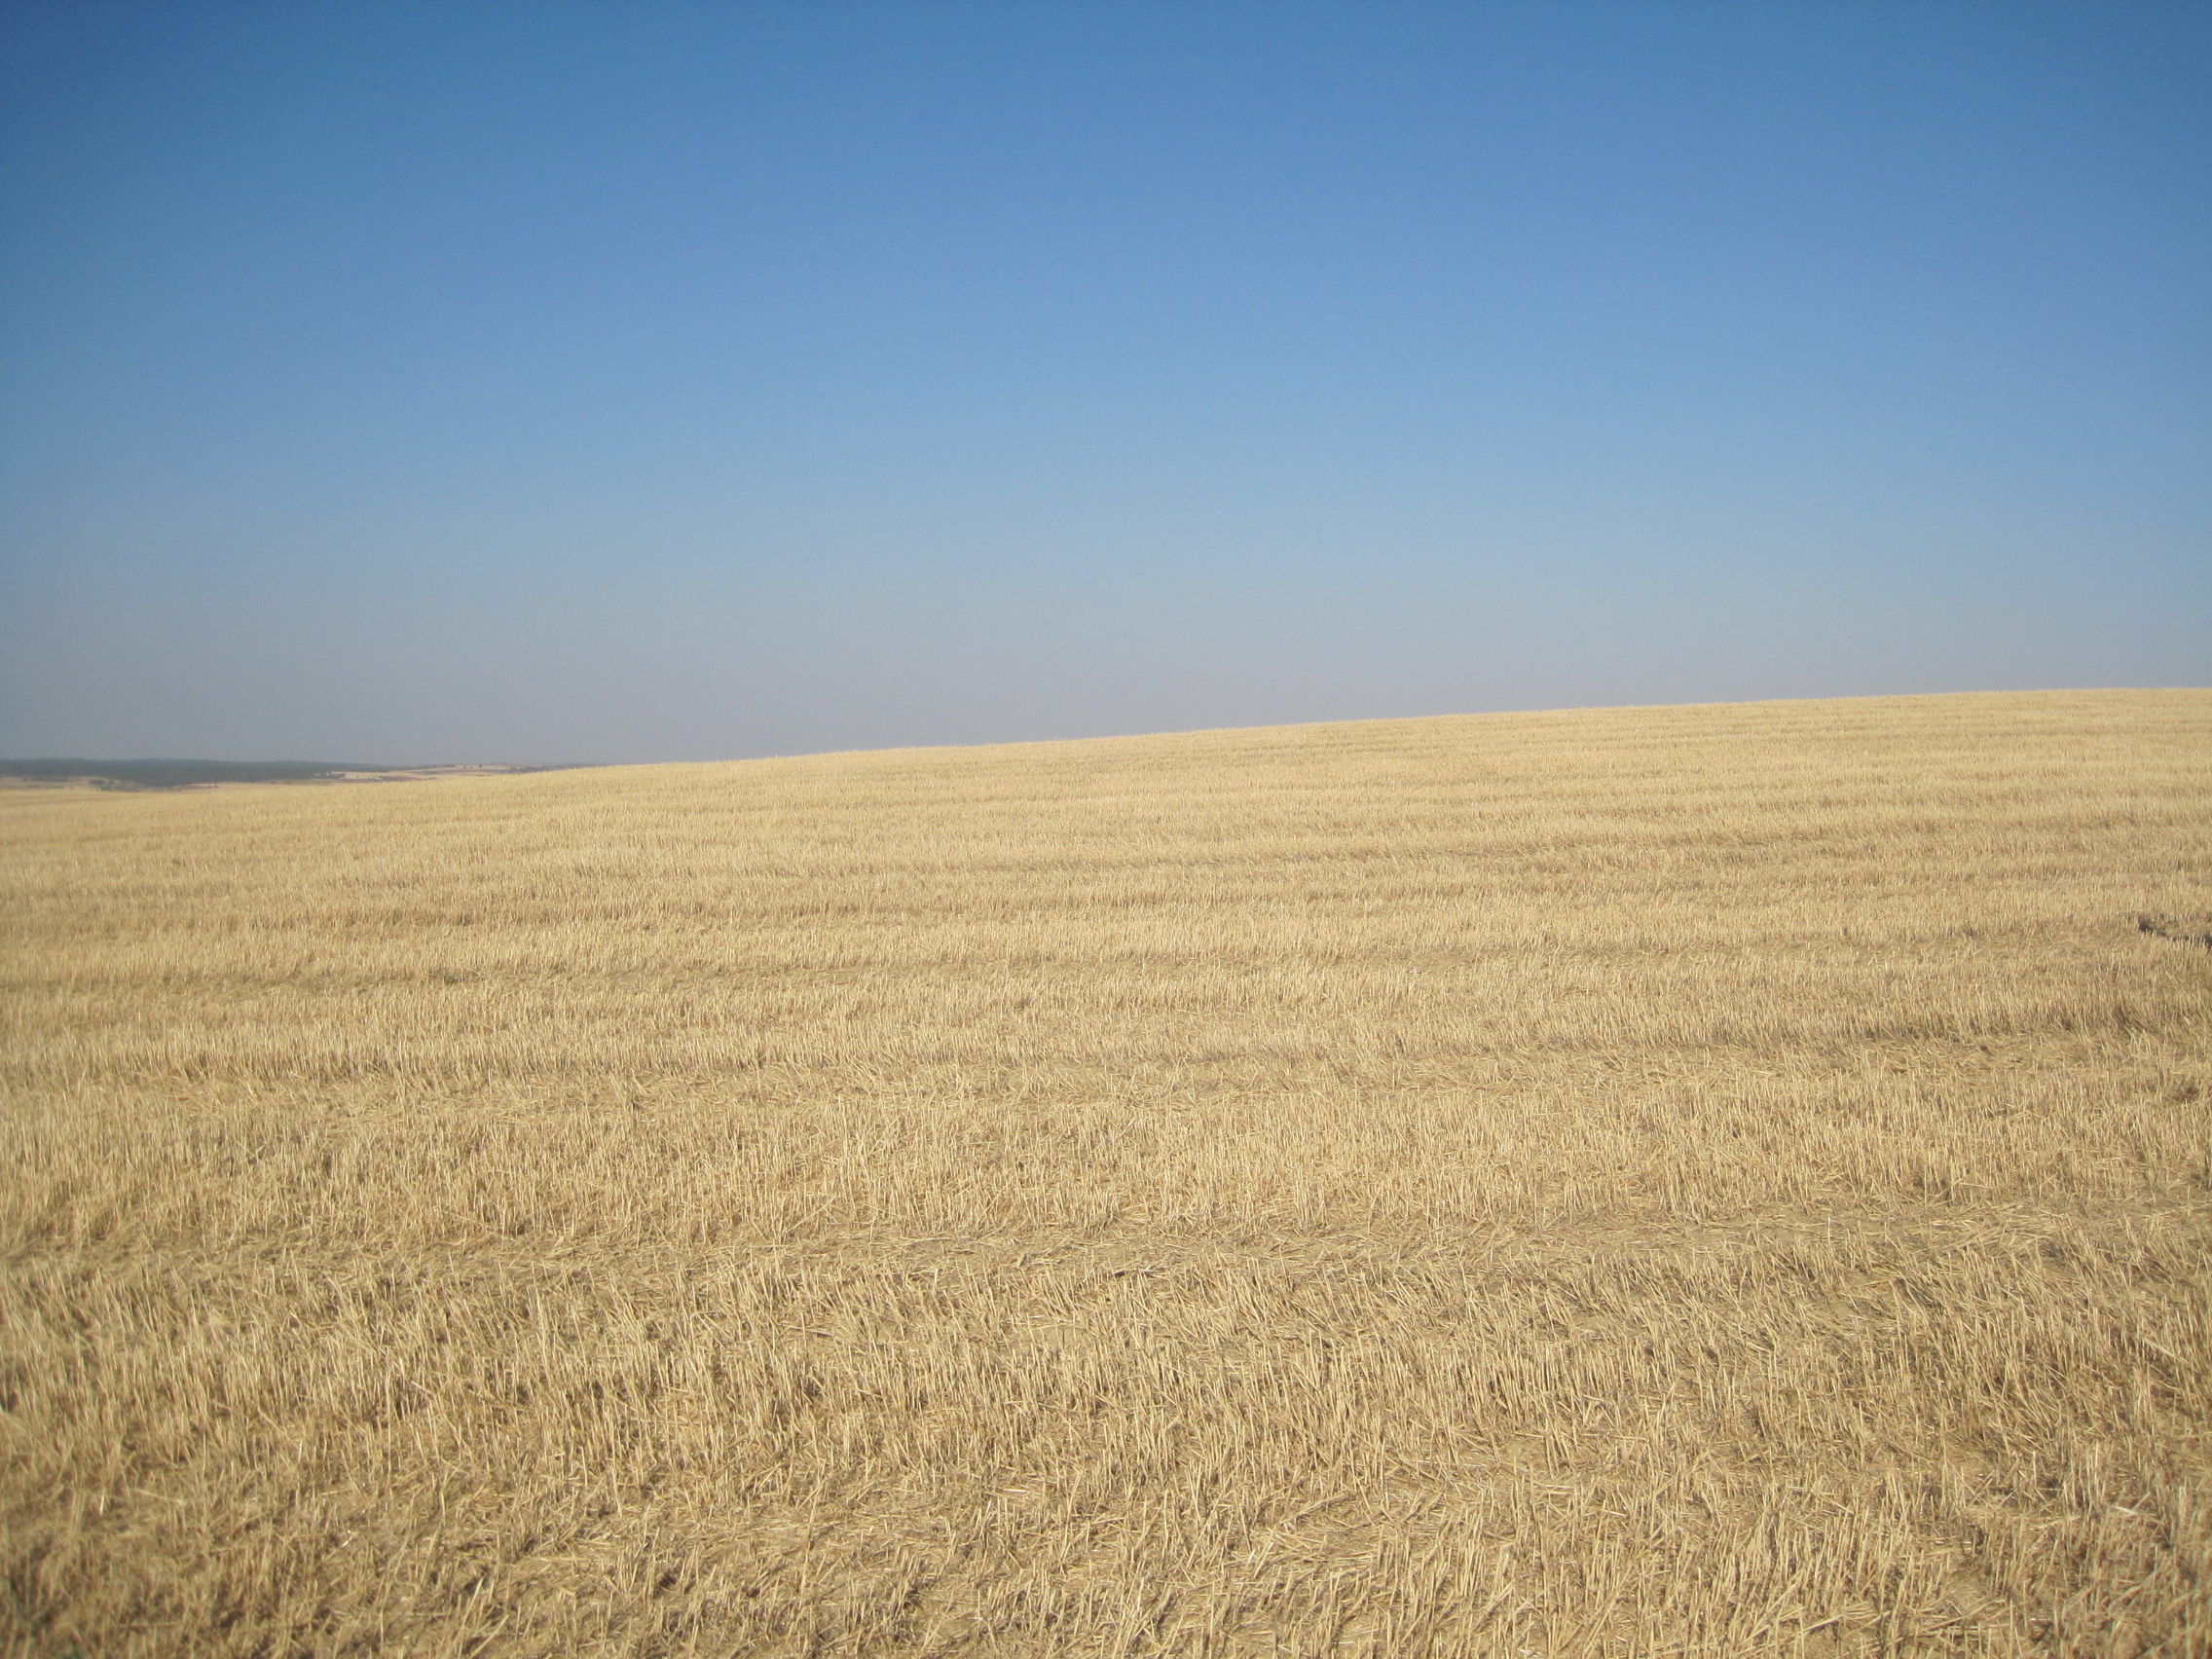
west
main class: Cropland
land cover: Barley
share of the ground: < 10 %
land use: Agriculture (excluding fallow land and kitchen gardens)
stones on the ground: < 10 %
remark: Harvested field
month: July
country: ES
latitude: 41.6000
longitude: -5.3778
